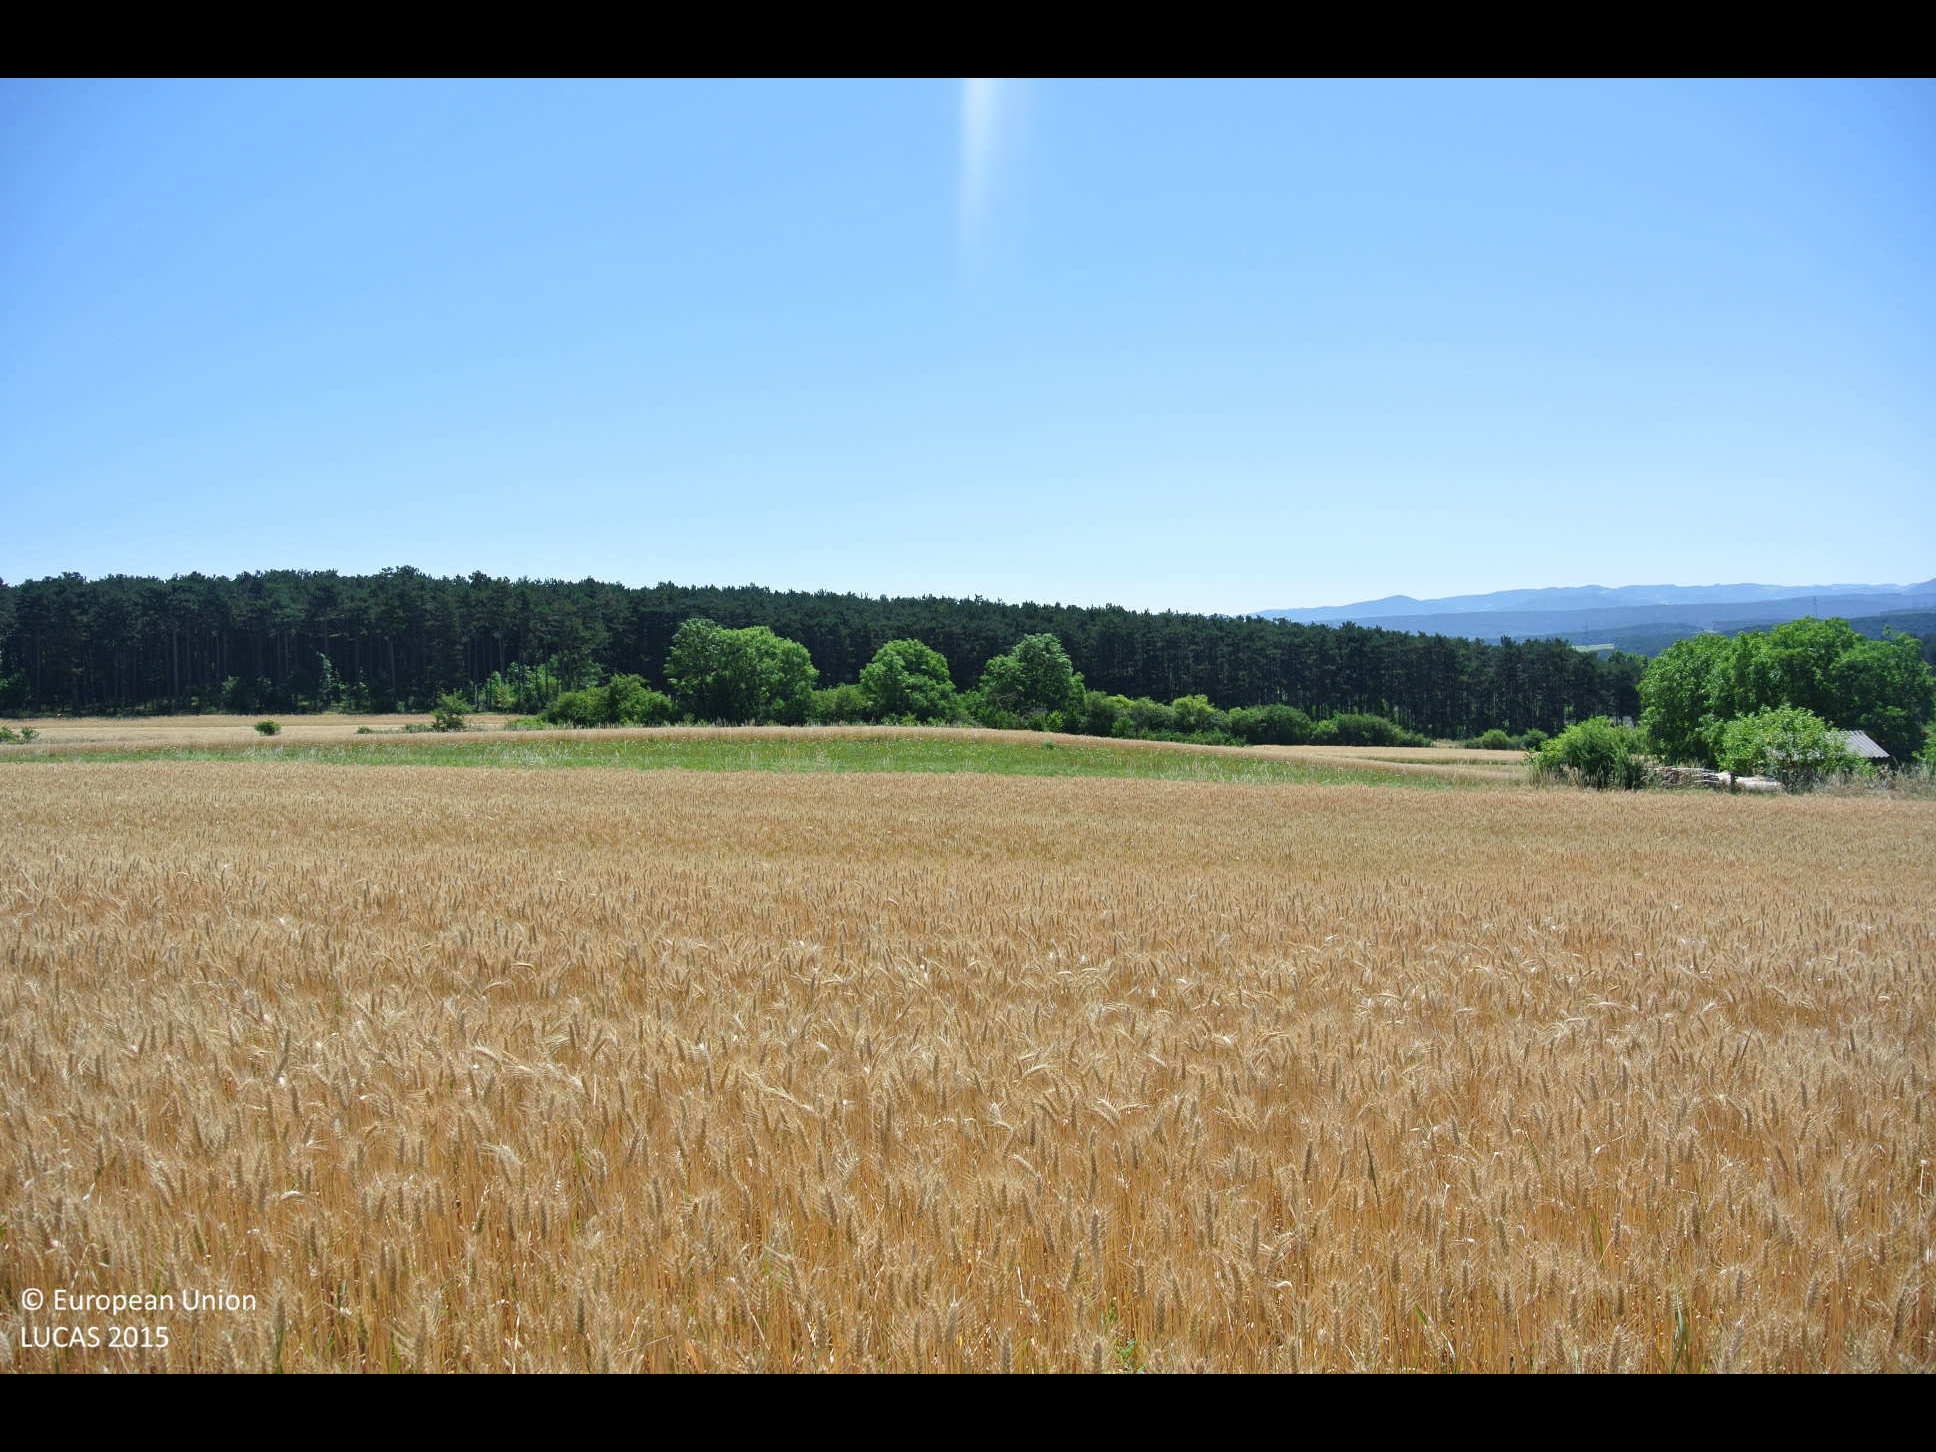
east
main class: Cropland
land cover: Durum wheat
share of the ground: > 75 %
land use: Agriculture (excluding fallow land and kitchen gardens)
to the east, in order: Durum wheat; Grass margins; Other bare soil; Grass margins; Other bare soil; Tracks; Grass margins; Spontaneously vegetated surfaces; Barley; Grass margins; Common wheat; Pine dominated coniferous woodland
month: July
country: AT
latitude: 47.7329
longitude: 16.0432
